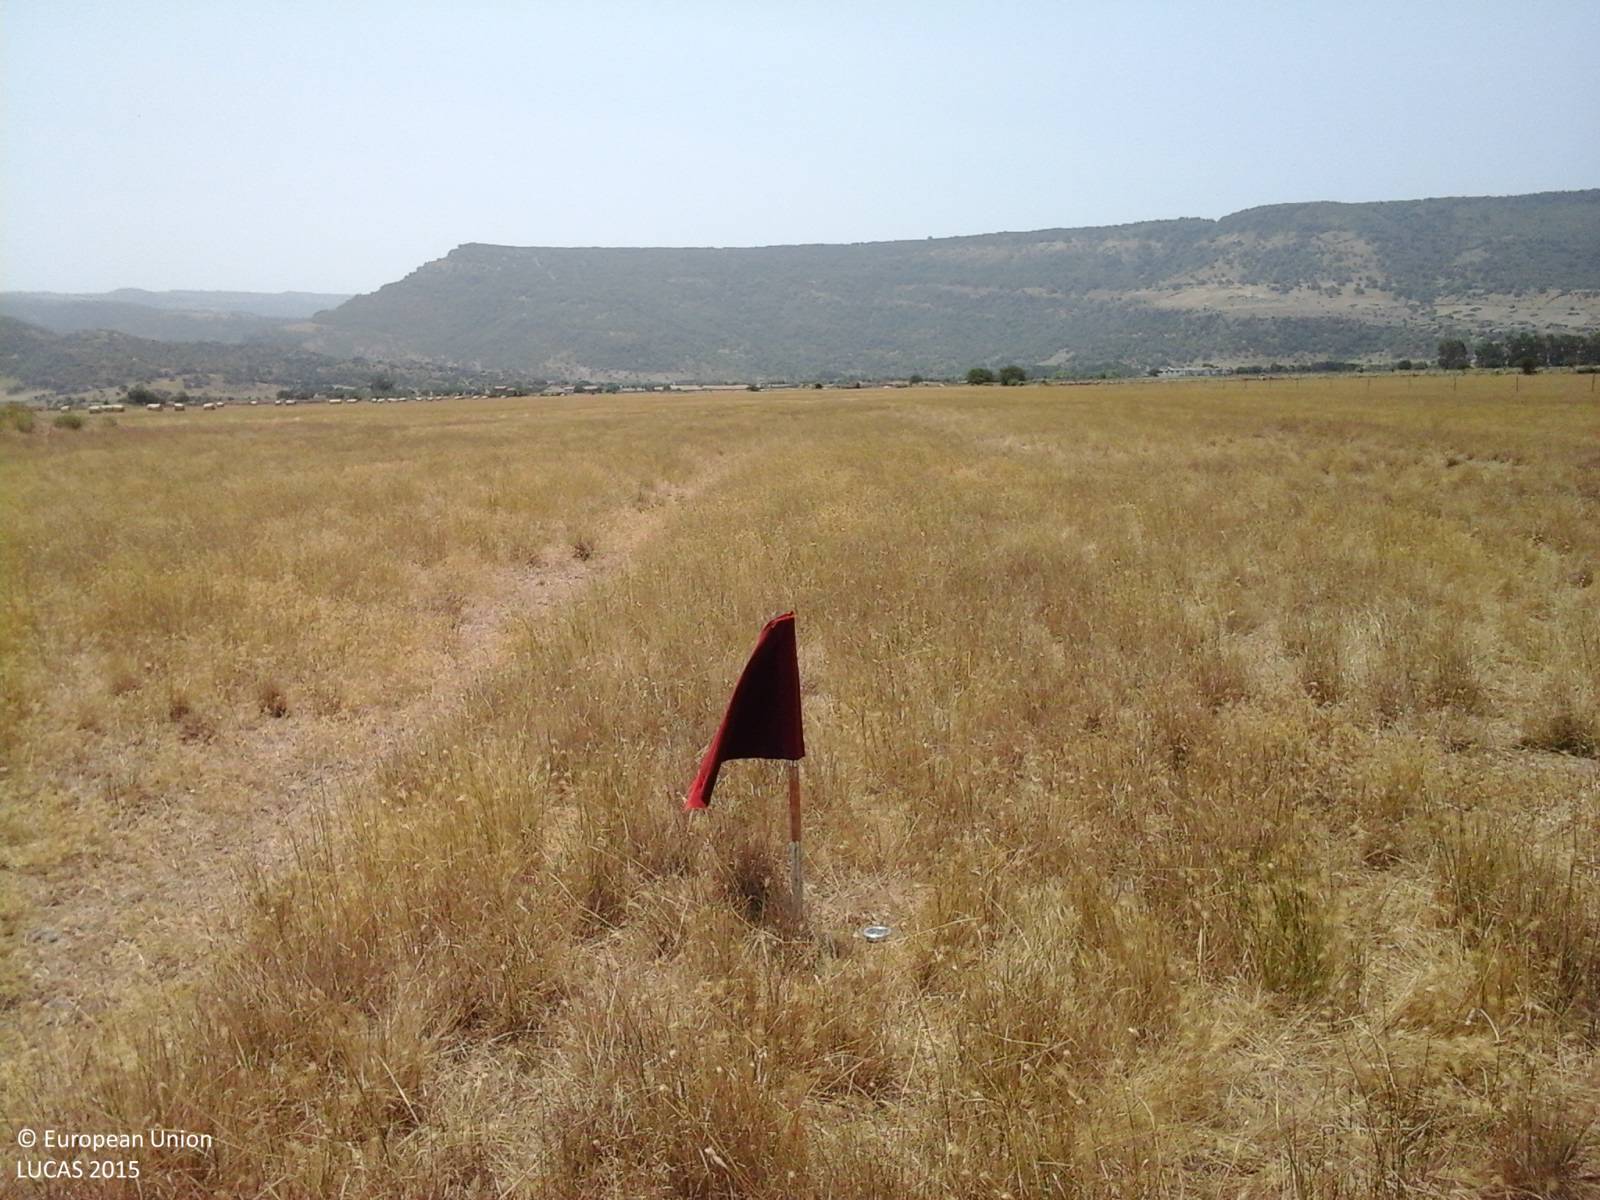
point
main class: Grassland
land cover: Grassland without tree/shrub cover
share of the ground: > 75 %
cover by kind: herbaceous plants 100 %
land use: Agriculture (excluding fallow land and kitchen gardens)
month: July
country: IT
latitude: 40.4415
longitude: 8.8387
